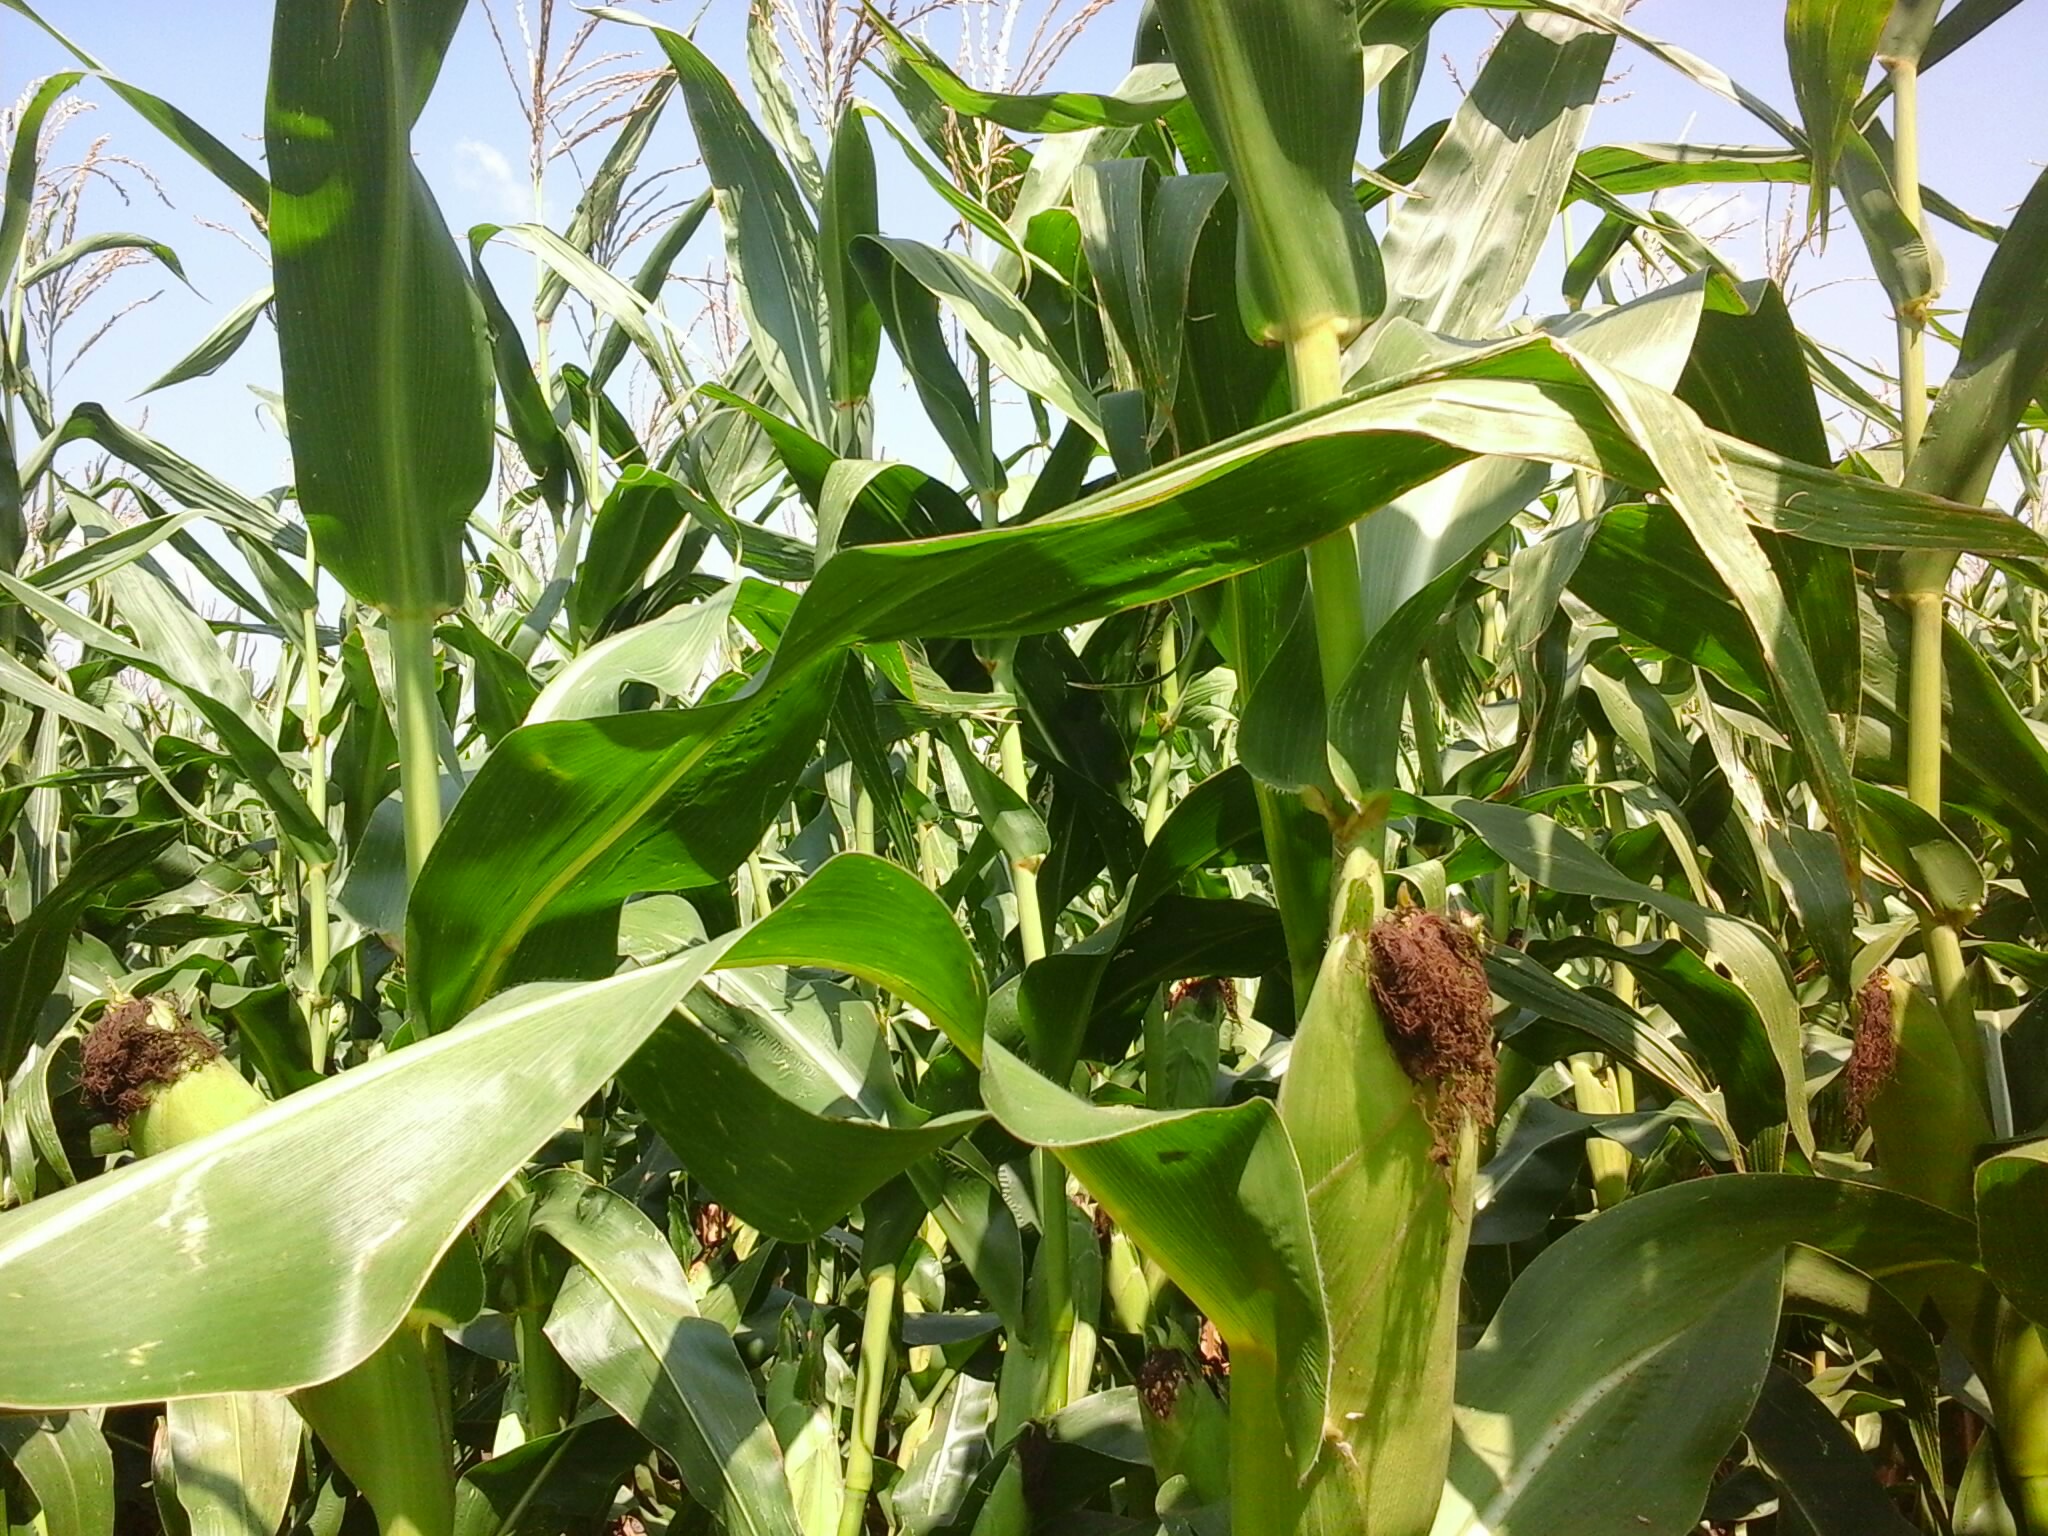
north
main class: Cropland
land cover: Maize
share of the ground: > 75 %
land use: Agriculture (excluding fallow land and kitchen gardens)
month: August
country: HU
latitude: 47.3857
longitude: 18.5312
